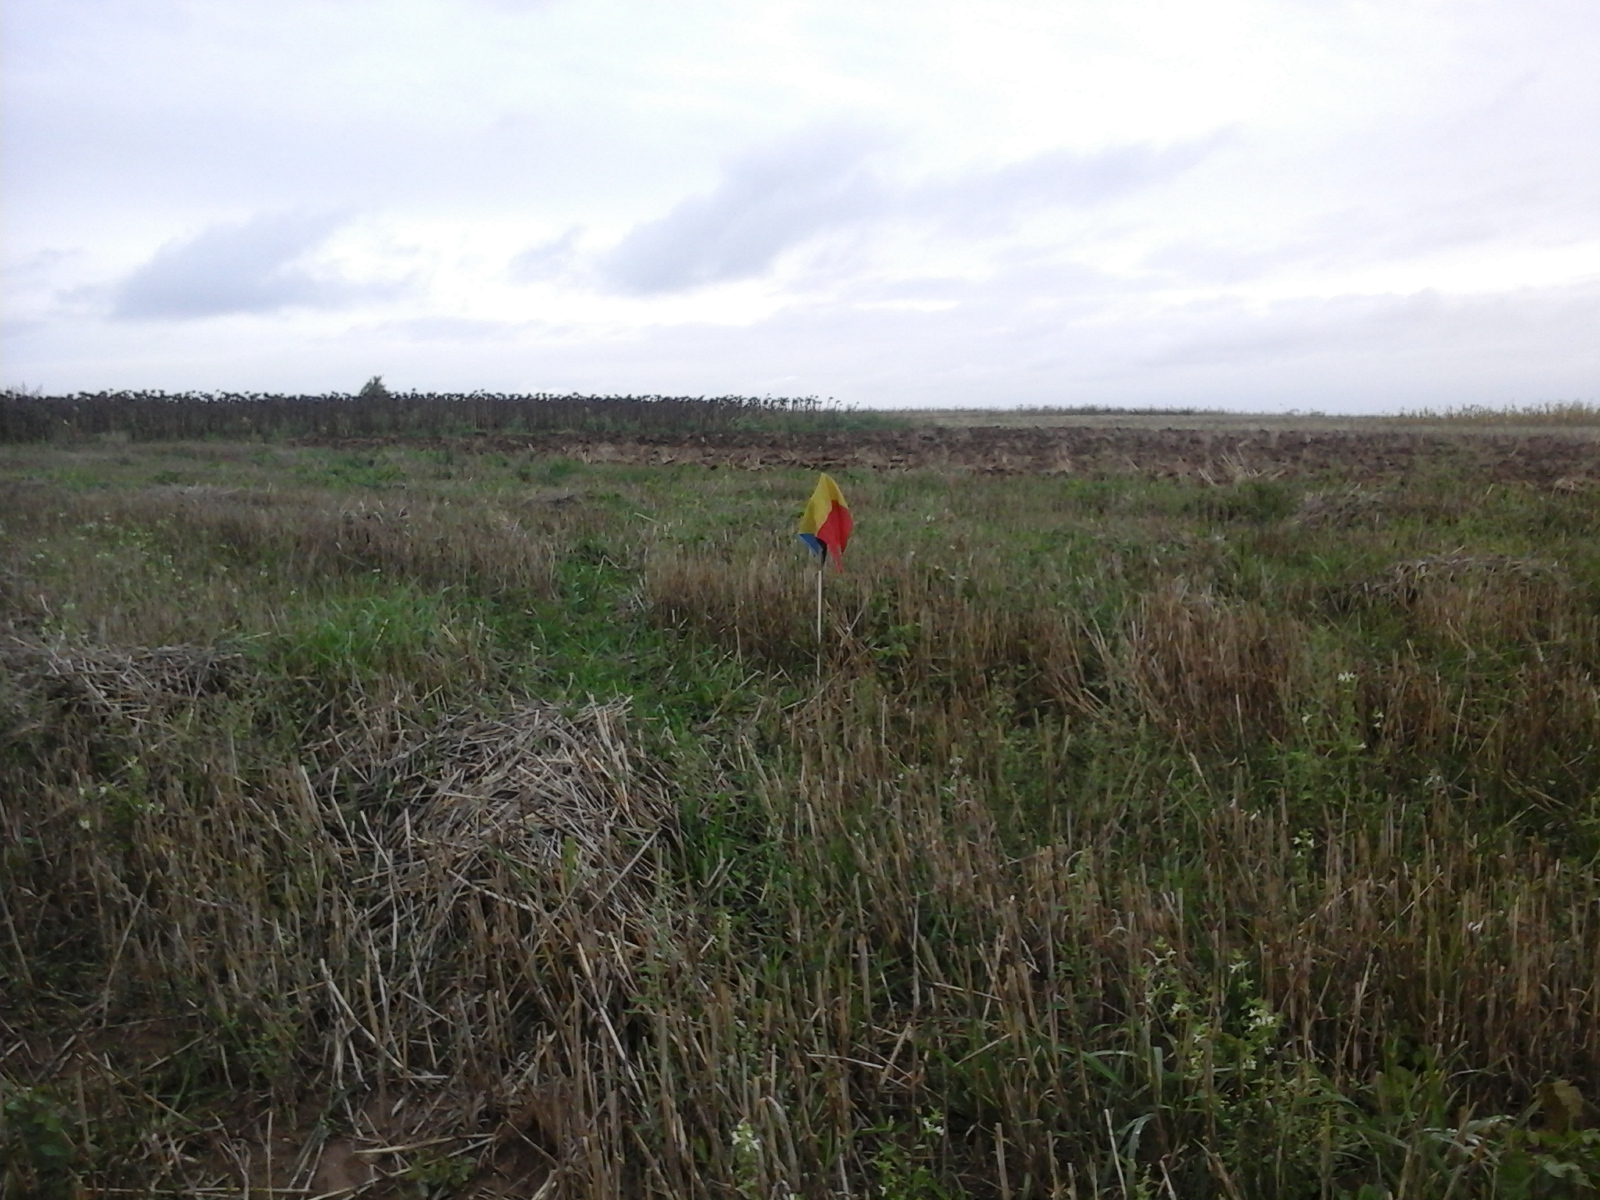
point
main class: Cropland
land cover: Common wheat
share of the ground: > 75 %
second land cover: Spontaneously vegetated surfaces
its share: 50 - 75 %
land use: Agriculture (excluding fallow land and kitchen gardens)
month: September
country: RO
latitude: 47.1489
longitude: 21.9825
